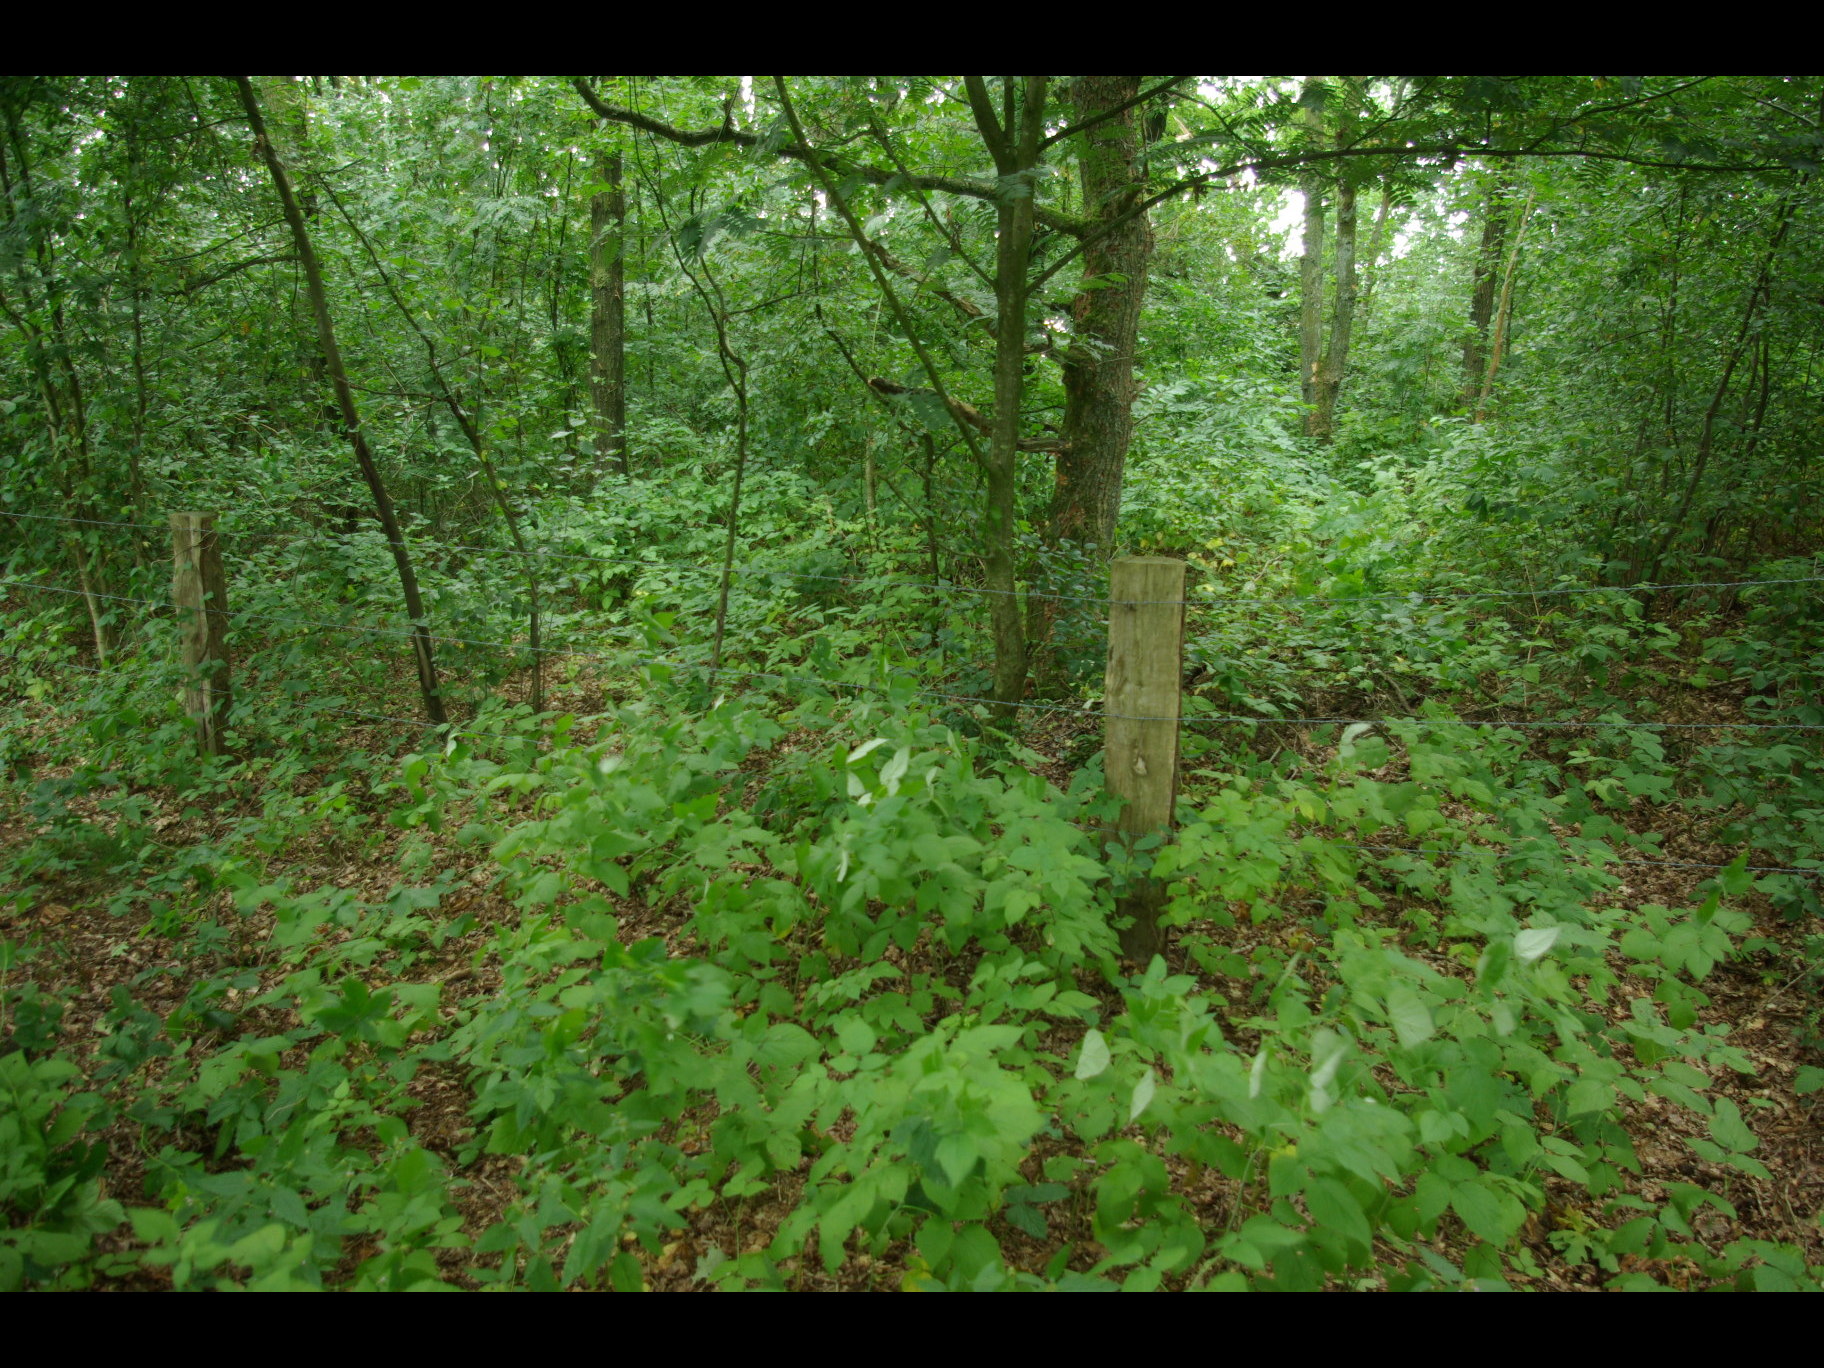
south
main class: Woodland
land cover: Broadleaved woodland
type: mesophytic deciduous forest
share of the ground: > 75 %
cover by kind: broadleaved forest trees 80 %, shrubs 10 %, herbaceous plants 10 %
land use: Semi-natural and natural areas not in use
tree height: > 5 m
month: August
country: DE
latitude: 54.6219
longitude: 9.2726
